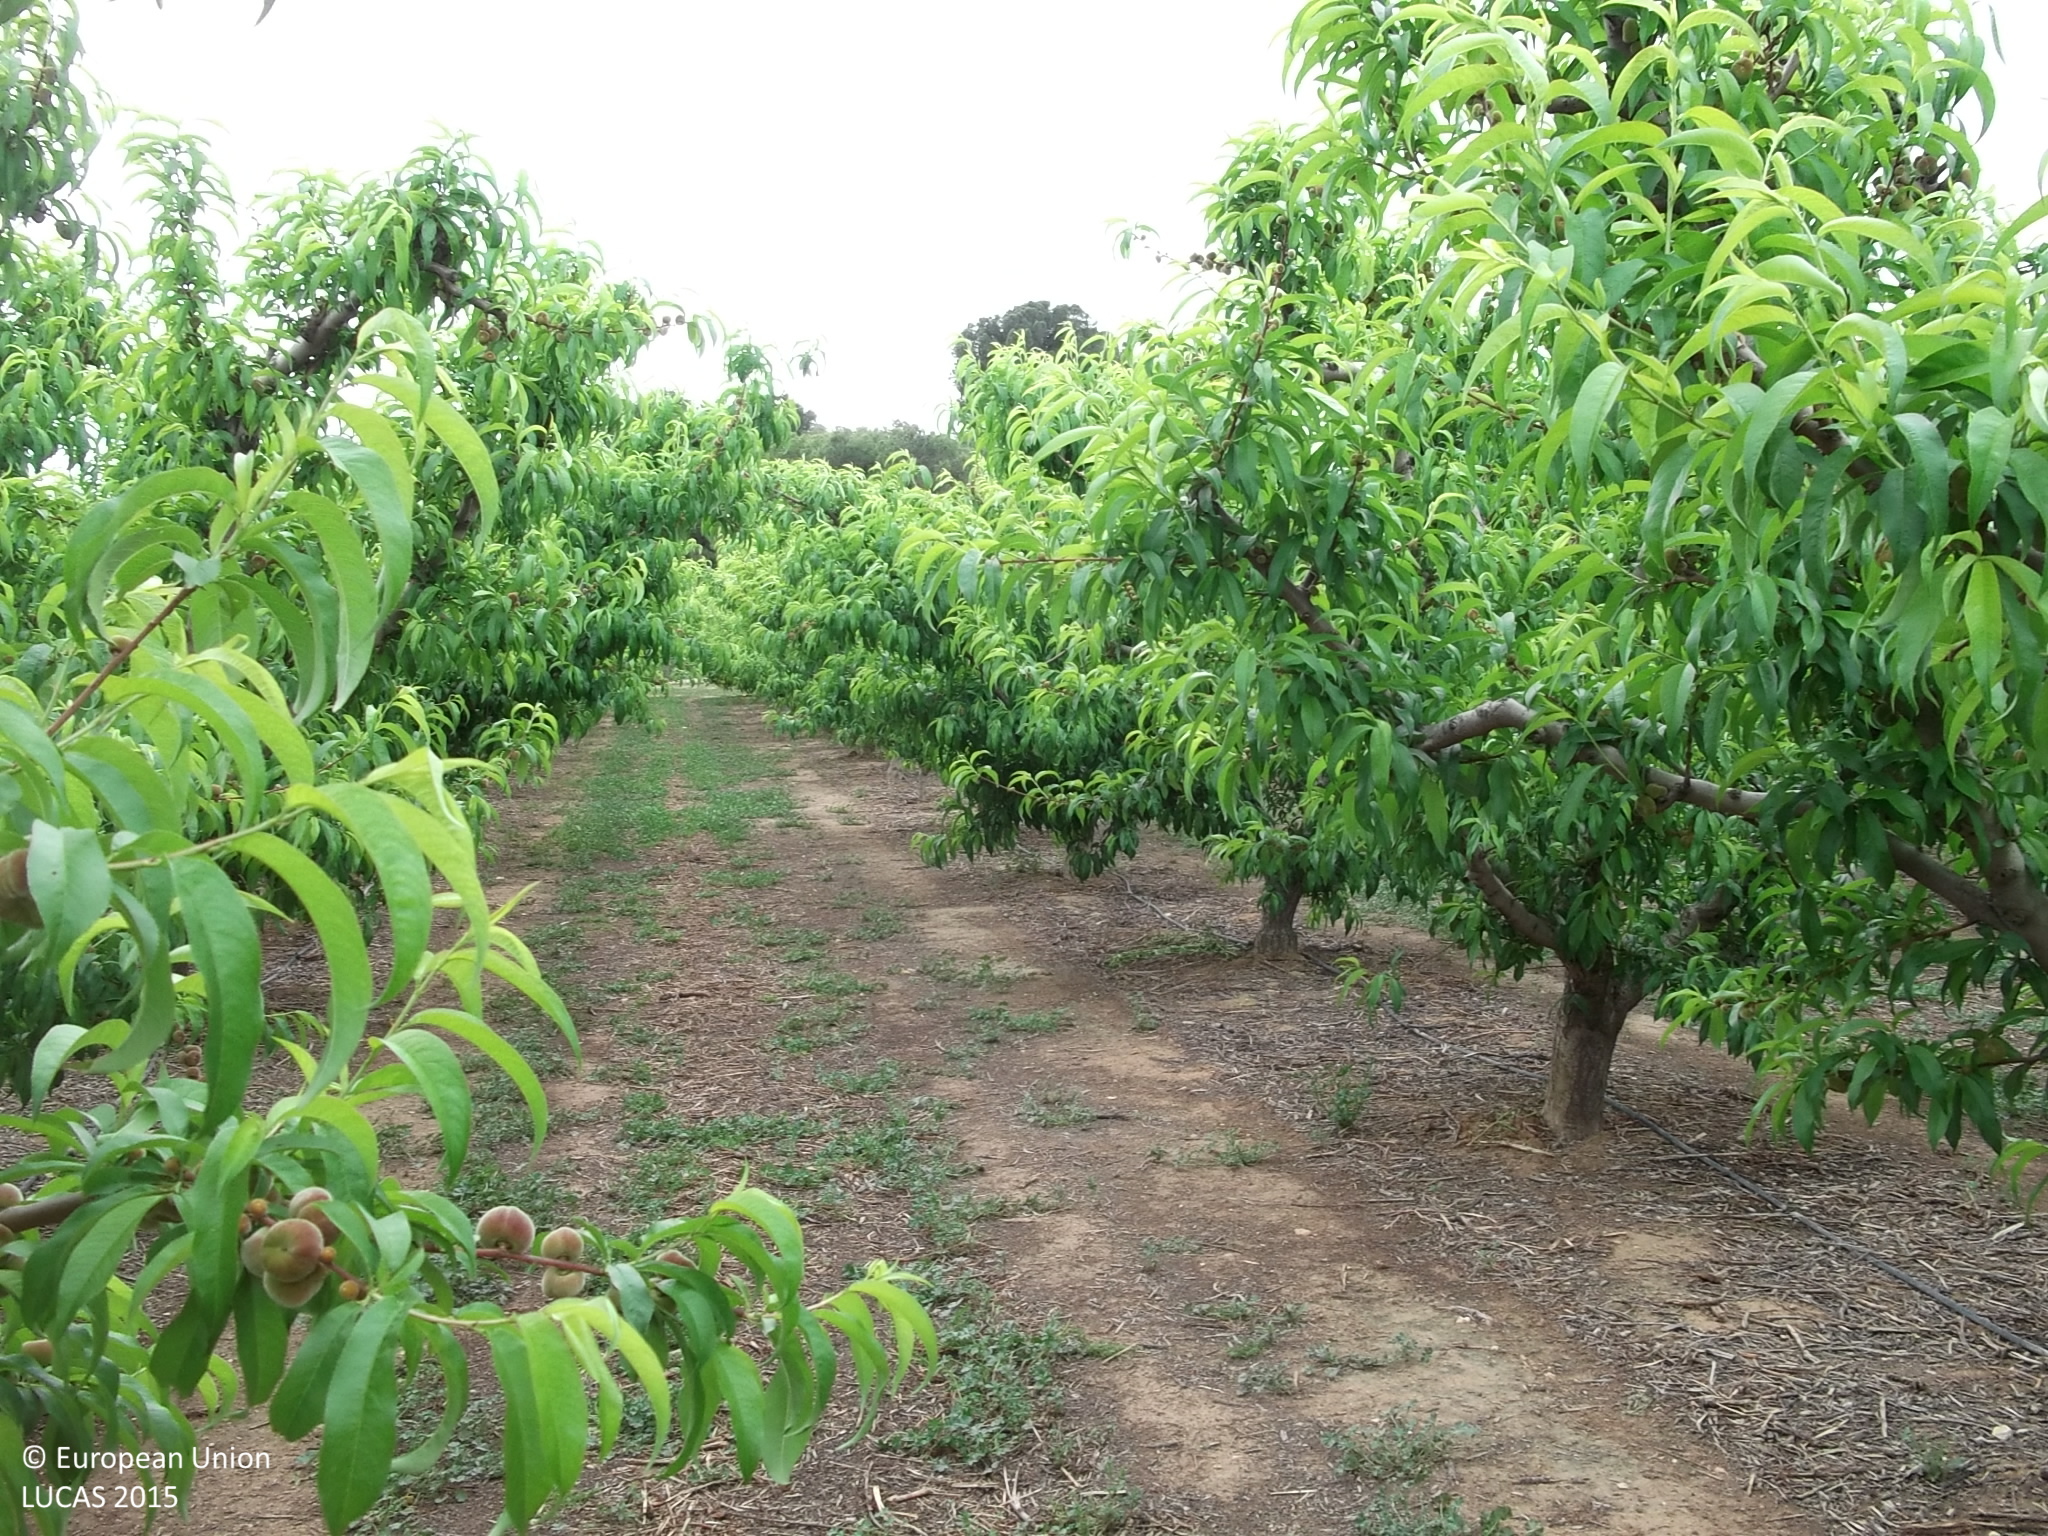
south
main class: Cropland
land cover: Other fruit trees and berries
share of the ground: 25 - 50 %
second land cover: Spontaneously vegetated surfaces
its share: 50 - 75 %
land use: Agriculture (excluding fallow land and kitchen gardens)
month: April
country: ES
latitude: 38.2204
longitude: -1.3300
